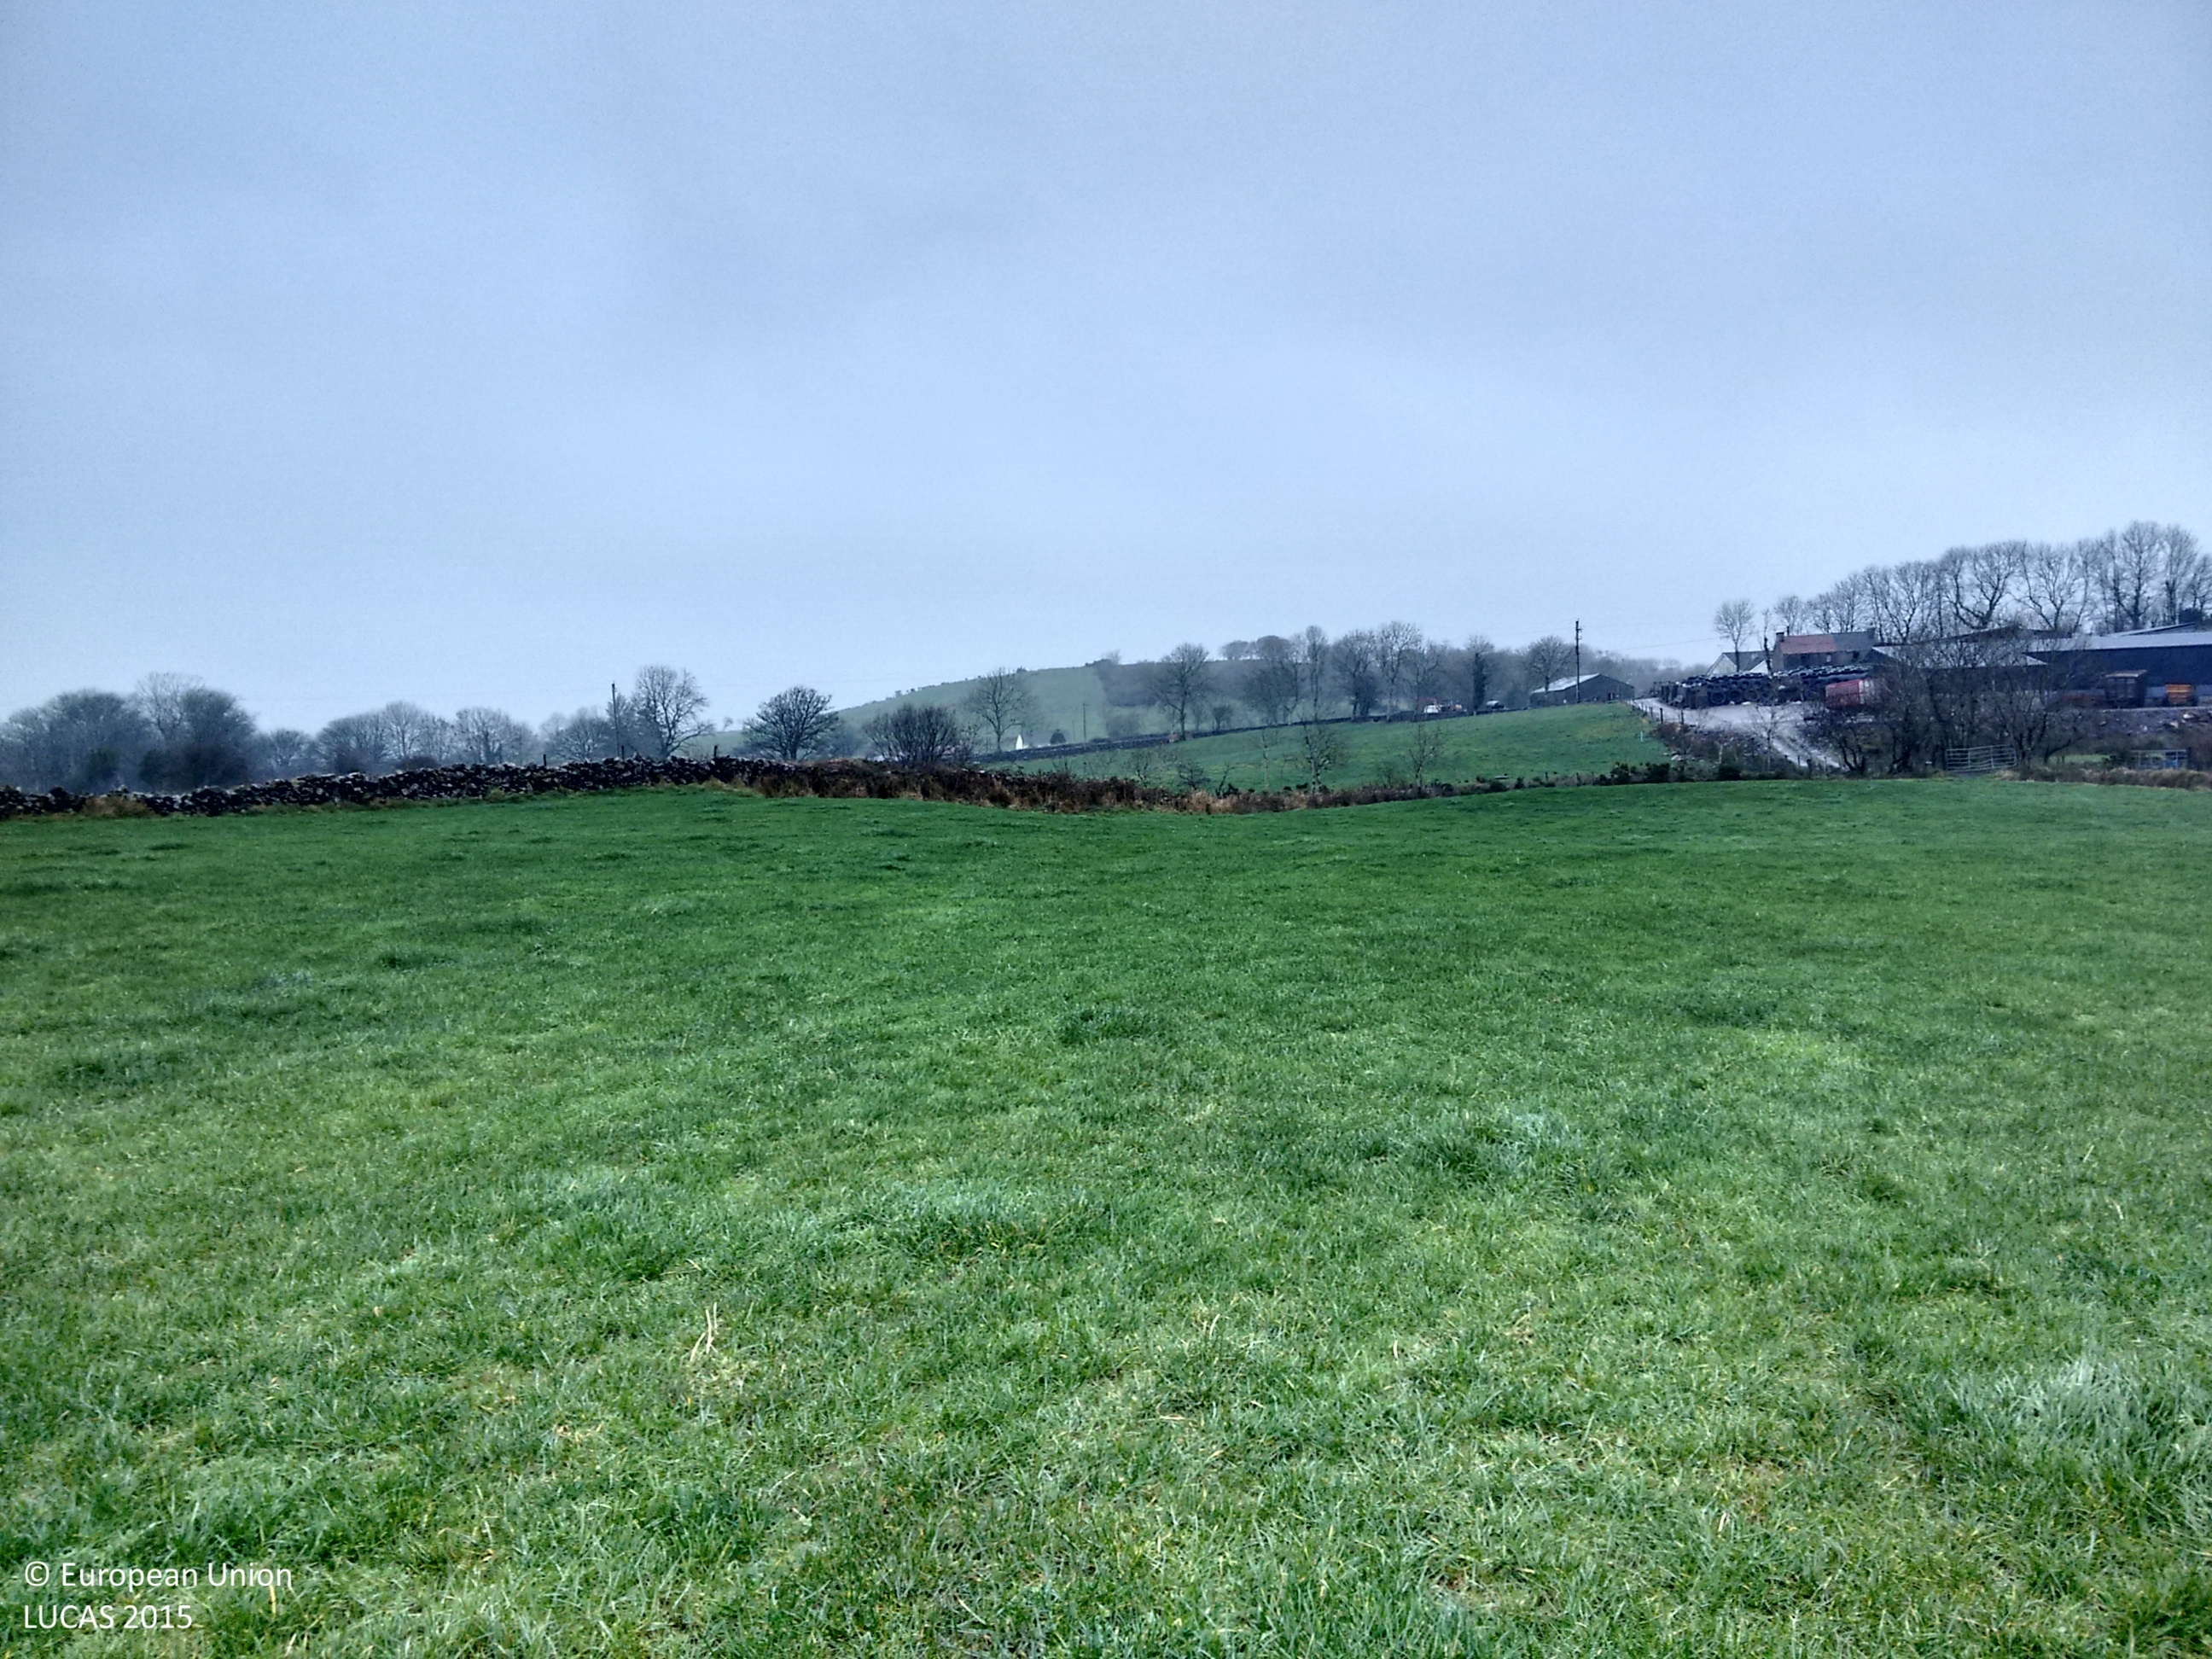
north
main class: Grassland
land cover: Grassland without tree/shrub cover
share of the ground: > 75 %
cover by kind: herbaceous plants 100 %
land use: Agriculture (excluding fallow land and kitchen gardens)
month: November
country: IE
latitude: 54.5341
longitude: -8.0875
